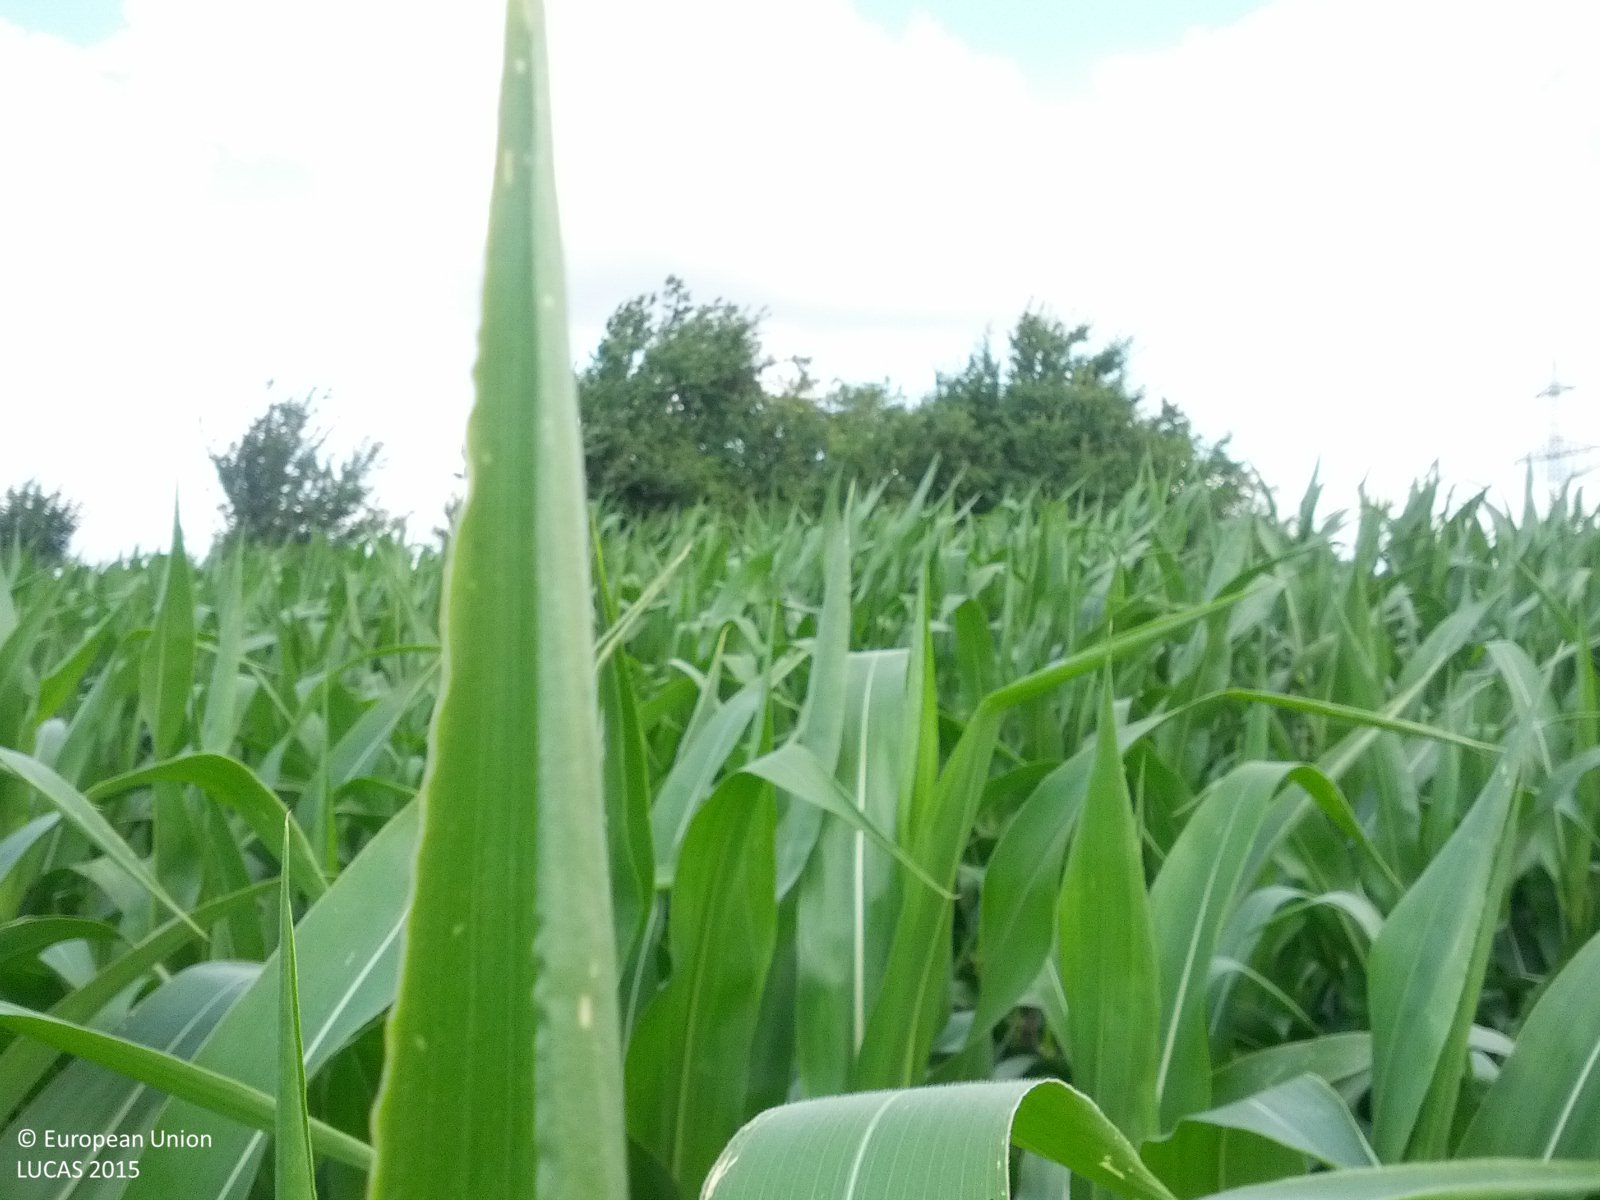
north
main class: Cropland
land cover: Maize
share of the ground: > 75 %
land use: Agriculture (excluding fallow land and kitchen gardens)
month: July
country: AT
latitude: 48.7081
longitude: 16.3520
